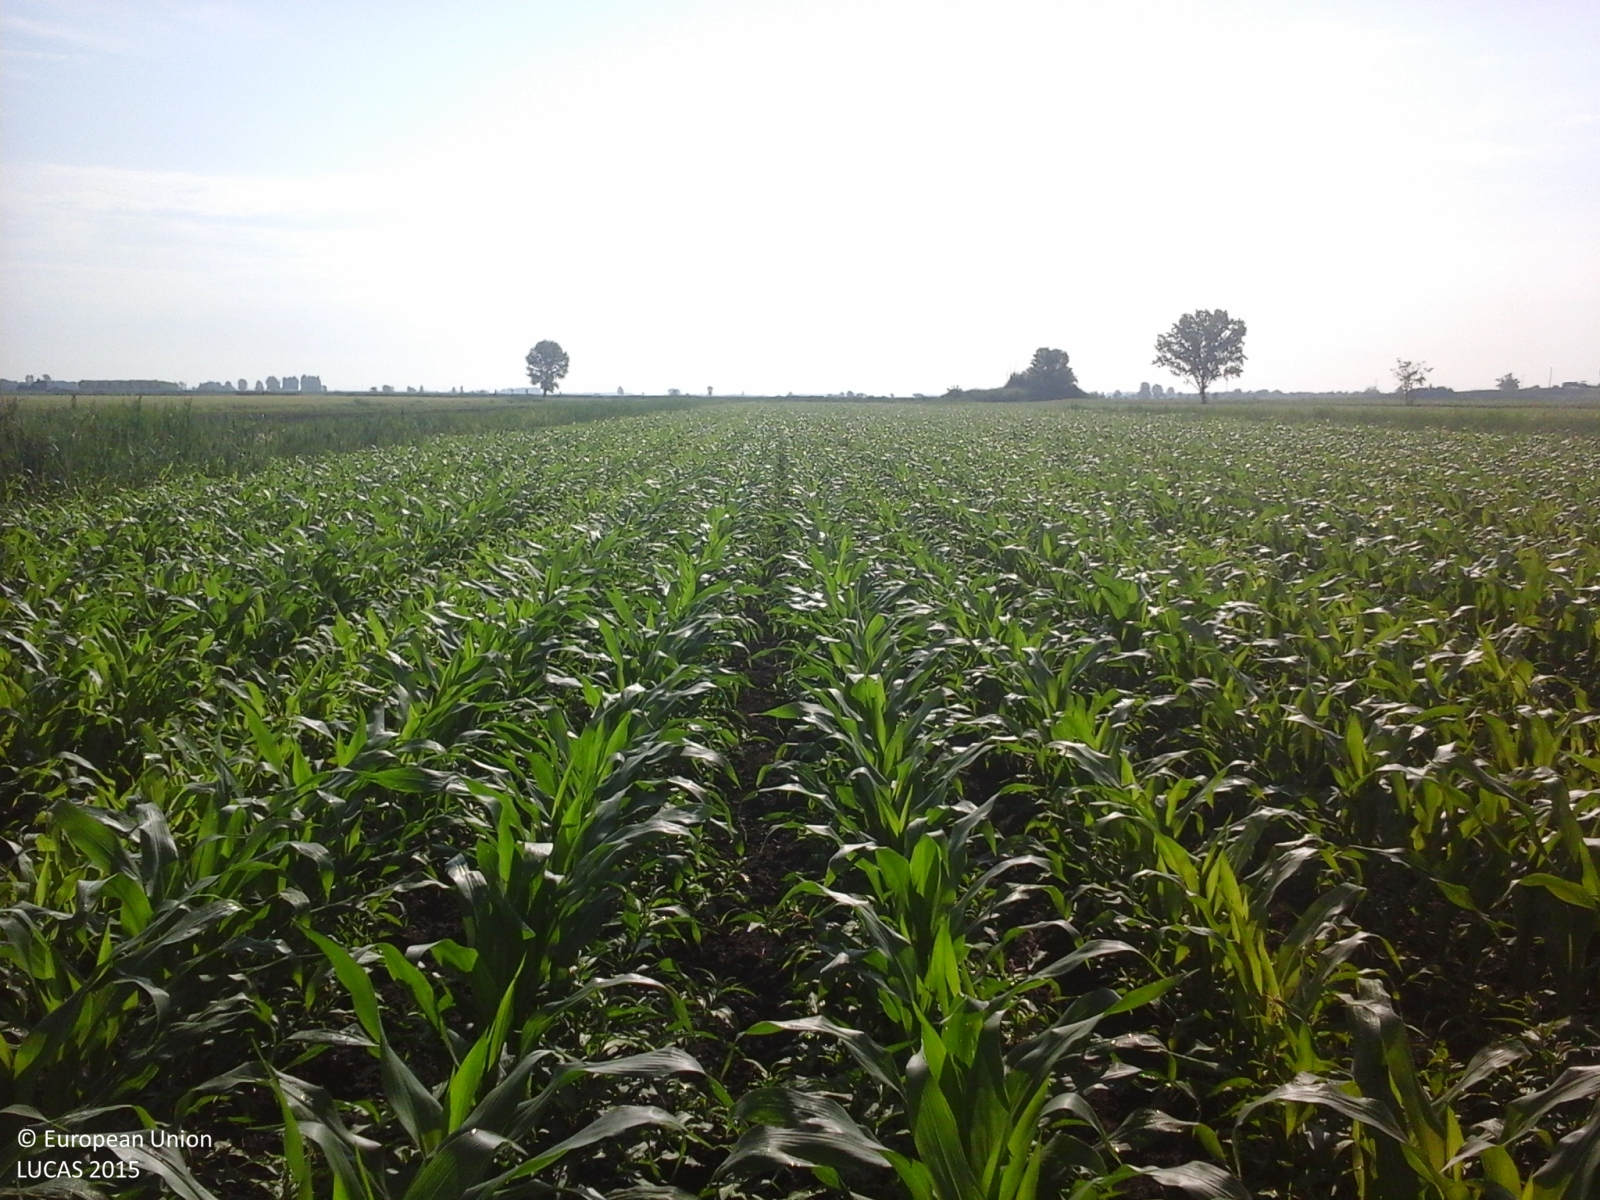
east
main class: Cropland
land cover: Maize
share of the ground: 50 - 75 %
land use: Agriculture (excluding fallow land and kitchen gardens)
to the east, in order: Maize
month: May
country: IT
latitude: 45.1012
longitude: 11.1797
